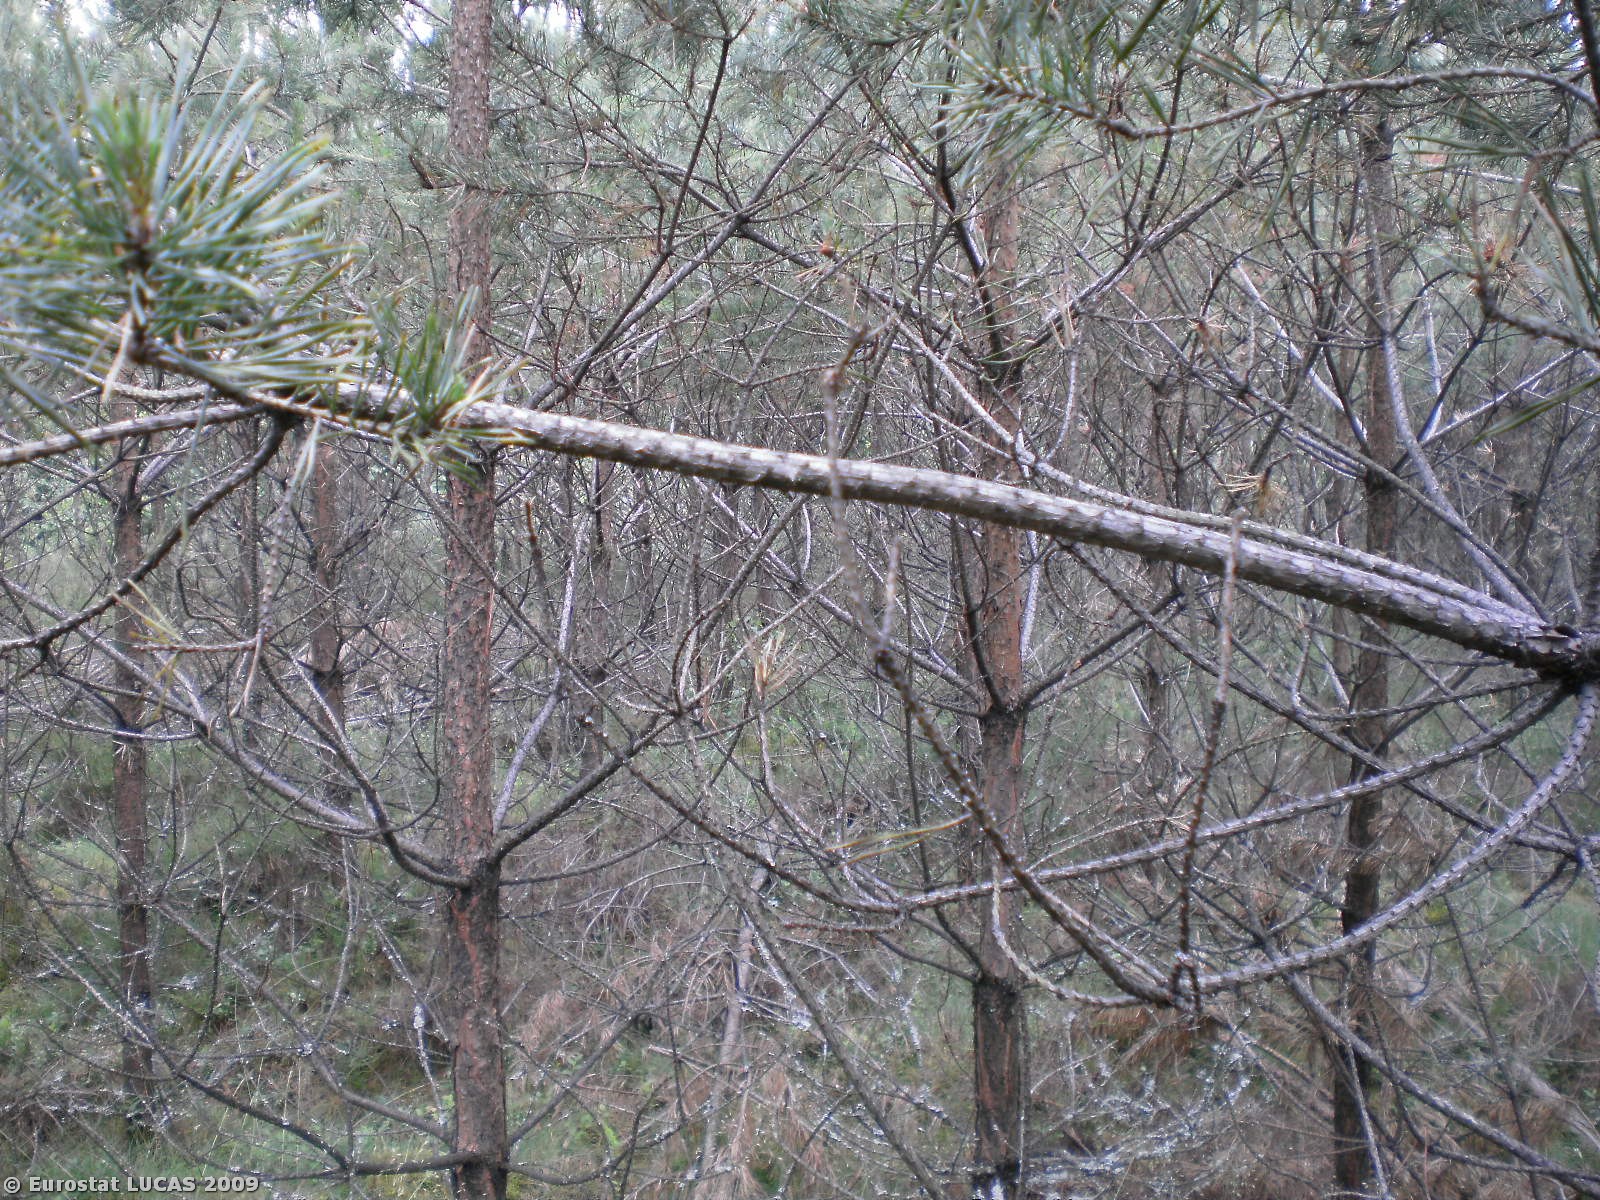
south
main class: Woodland
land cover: Coniferous woodland
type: hemiboreal forest and nemoral coniferous forest and mixed broadleaved-coniferous forest
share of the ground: > 75 %
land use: Forestry
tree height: > 5 m
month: July
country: PL
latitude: 54.2326
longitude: 17.8215
